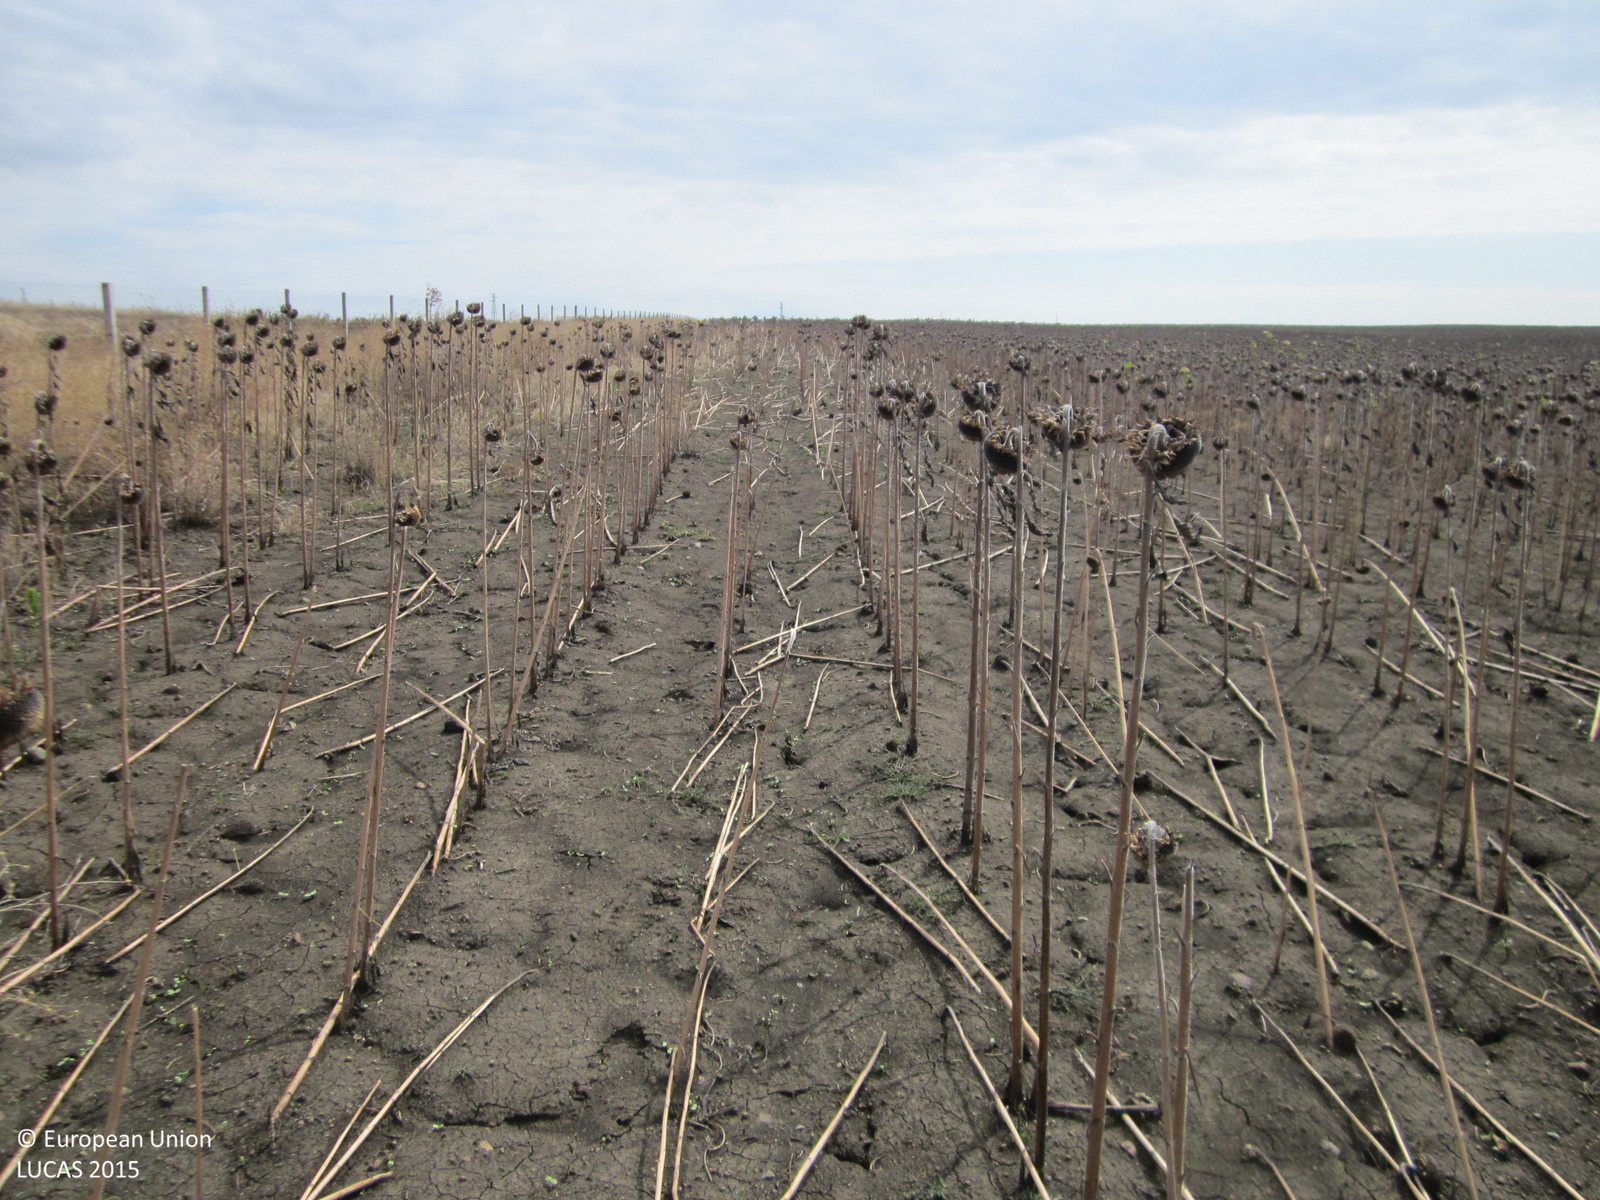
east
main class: Cropland
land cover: Sunflower
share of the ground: 50 - 75 %
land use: Agriculture (excluding fallow land and kitchen gardens)
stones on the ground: < 10 %
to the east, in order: Sunflower
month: August
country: BG
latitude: 42.5857
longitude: 27.1068
